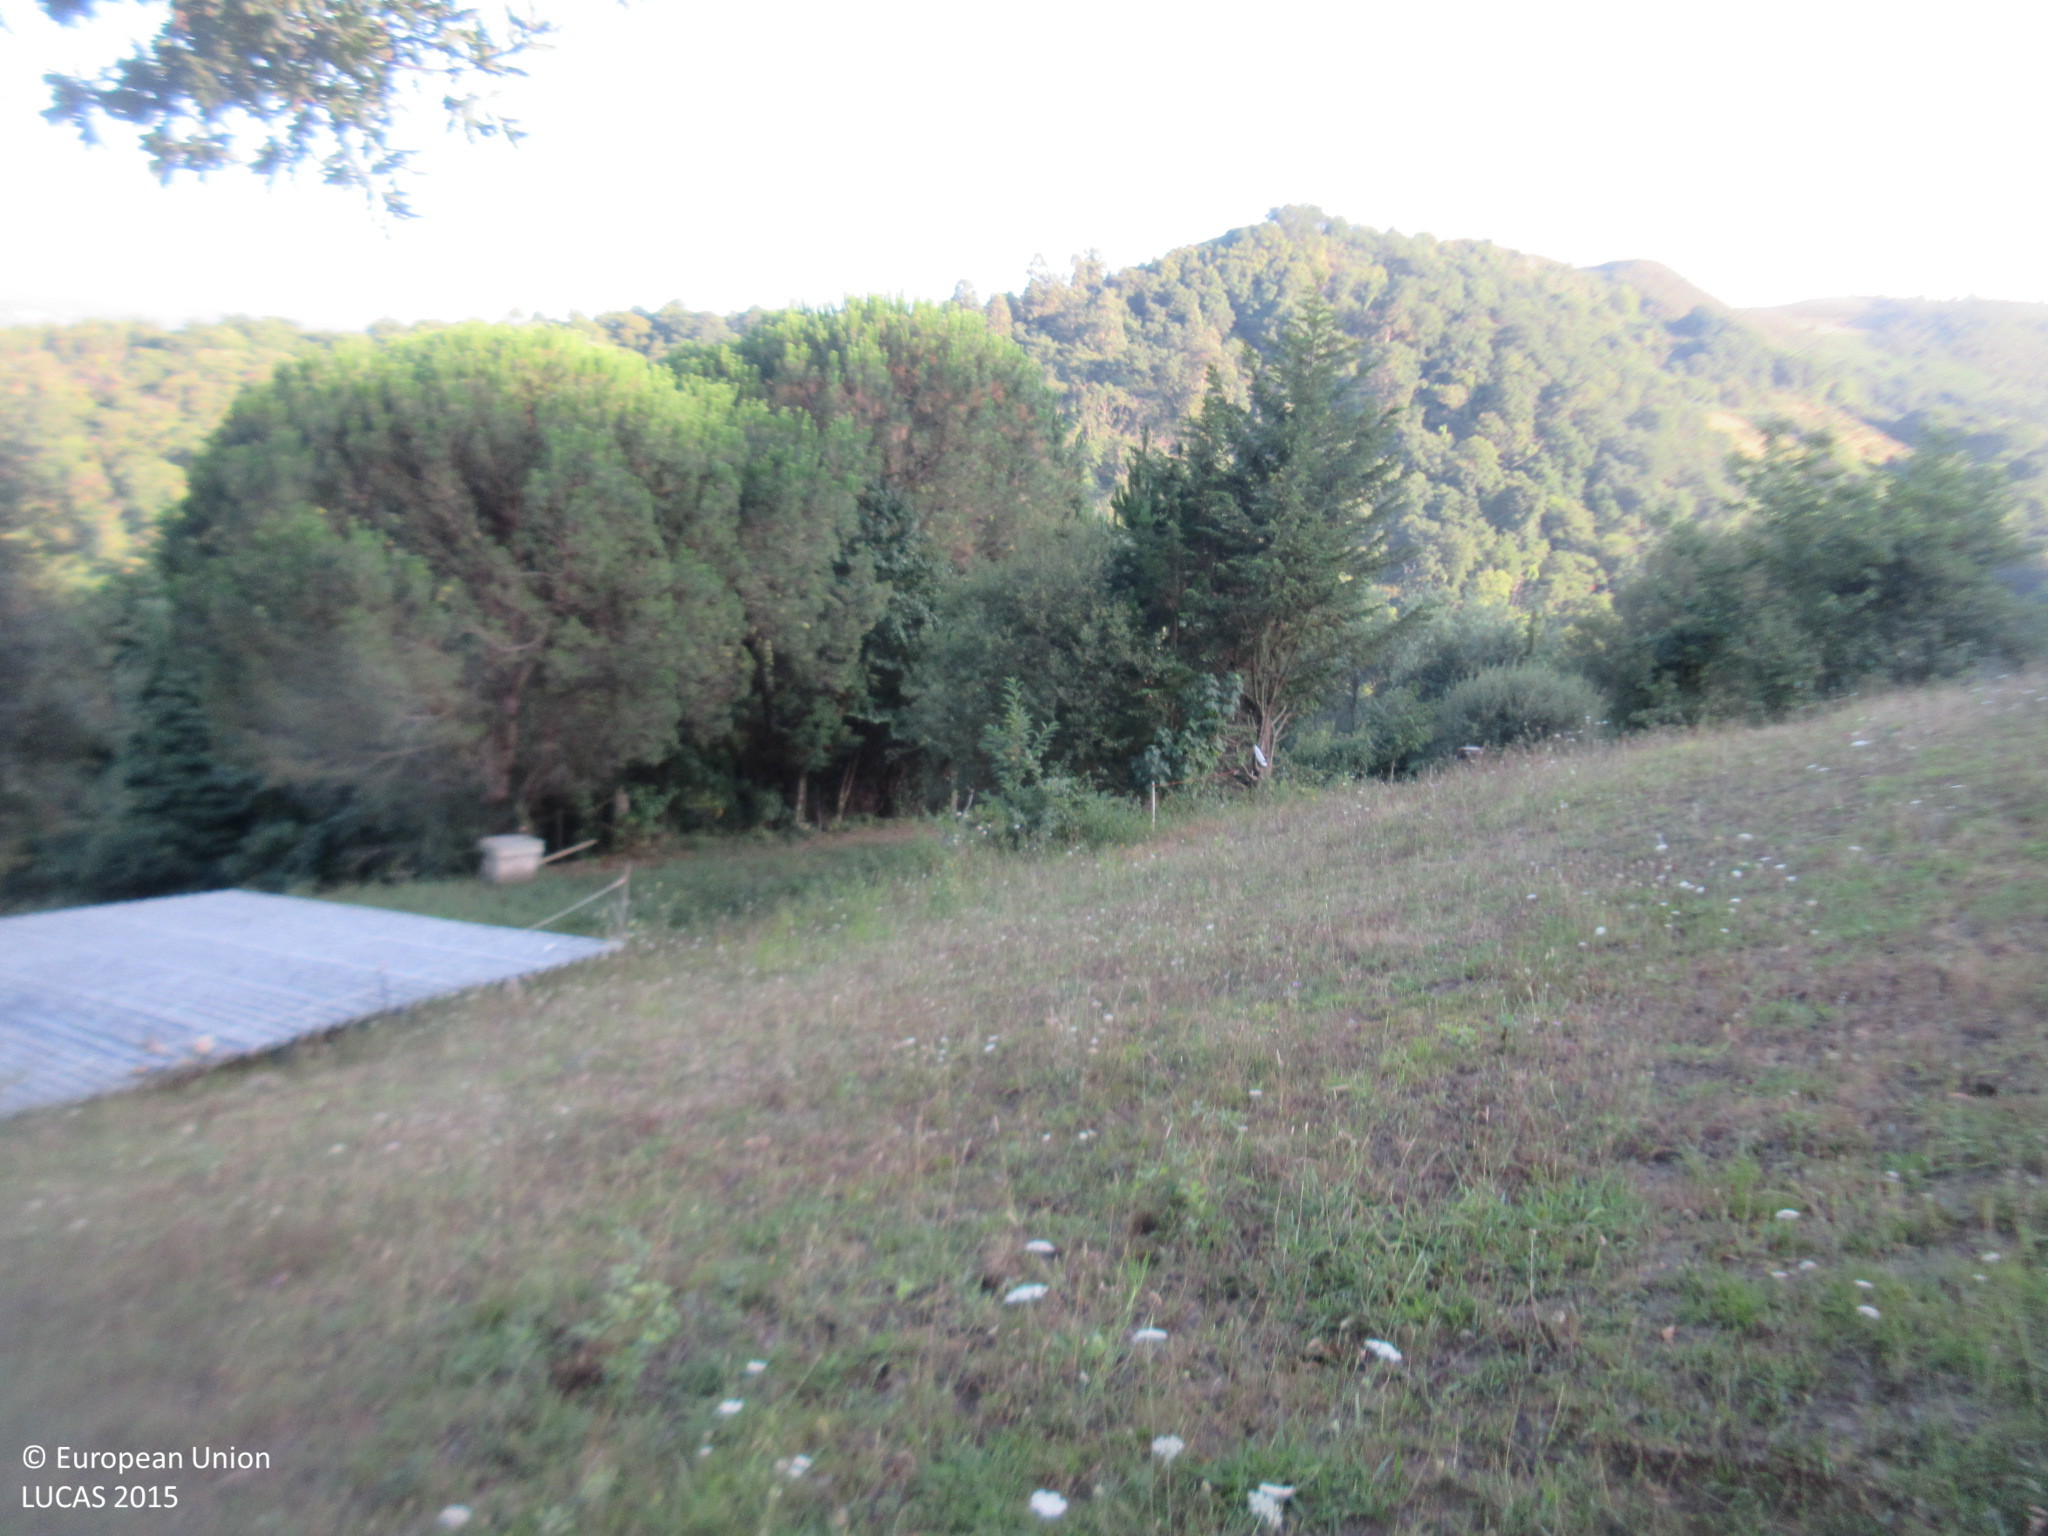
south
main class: Grassland
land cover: Grassland without tree/shrub cover
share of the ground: > 75 %
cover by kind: herbaceous plants 100 %
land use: Agriculture (excluding fallow land and kitchen gardens)
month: July
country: ES
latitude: 43.2380
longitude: -3.9523
